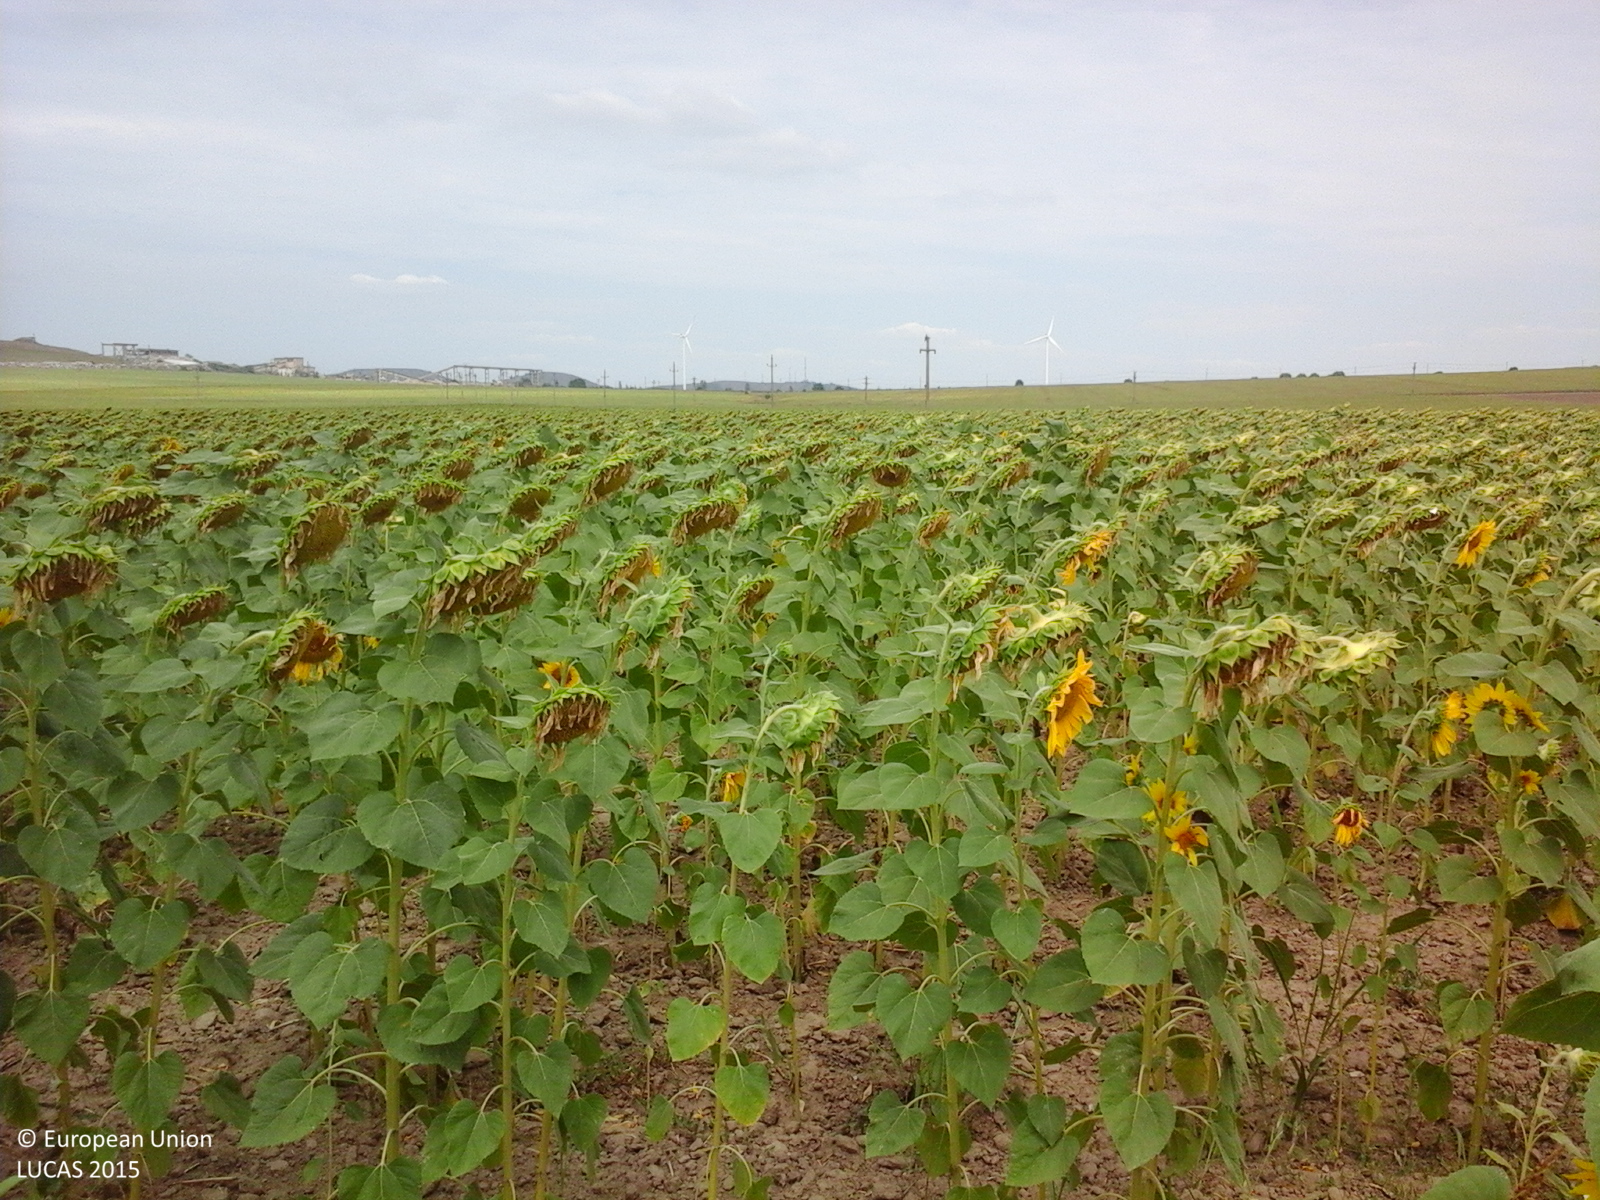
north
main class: Cropland
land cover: Sunflower
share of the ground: > 75 %
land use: Agriculture (excluding fallow land and kitchen gardens)
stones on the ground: < 10 %
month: August
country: RO
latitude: 45.0386
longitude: 29.0764
